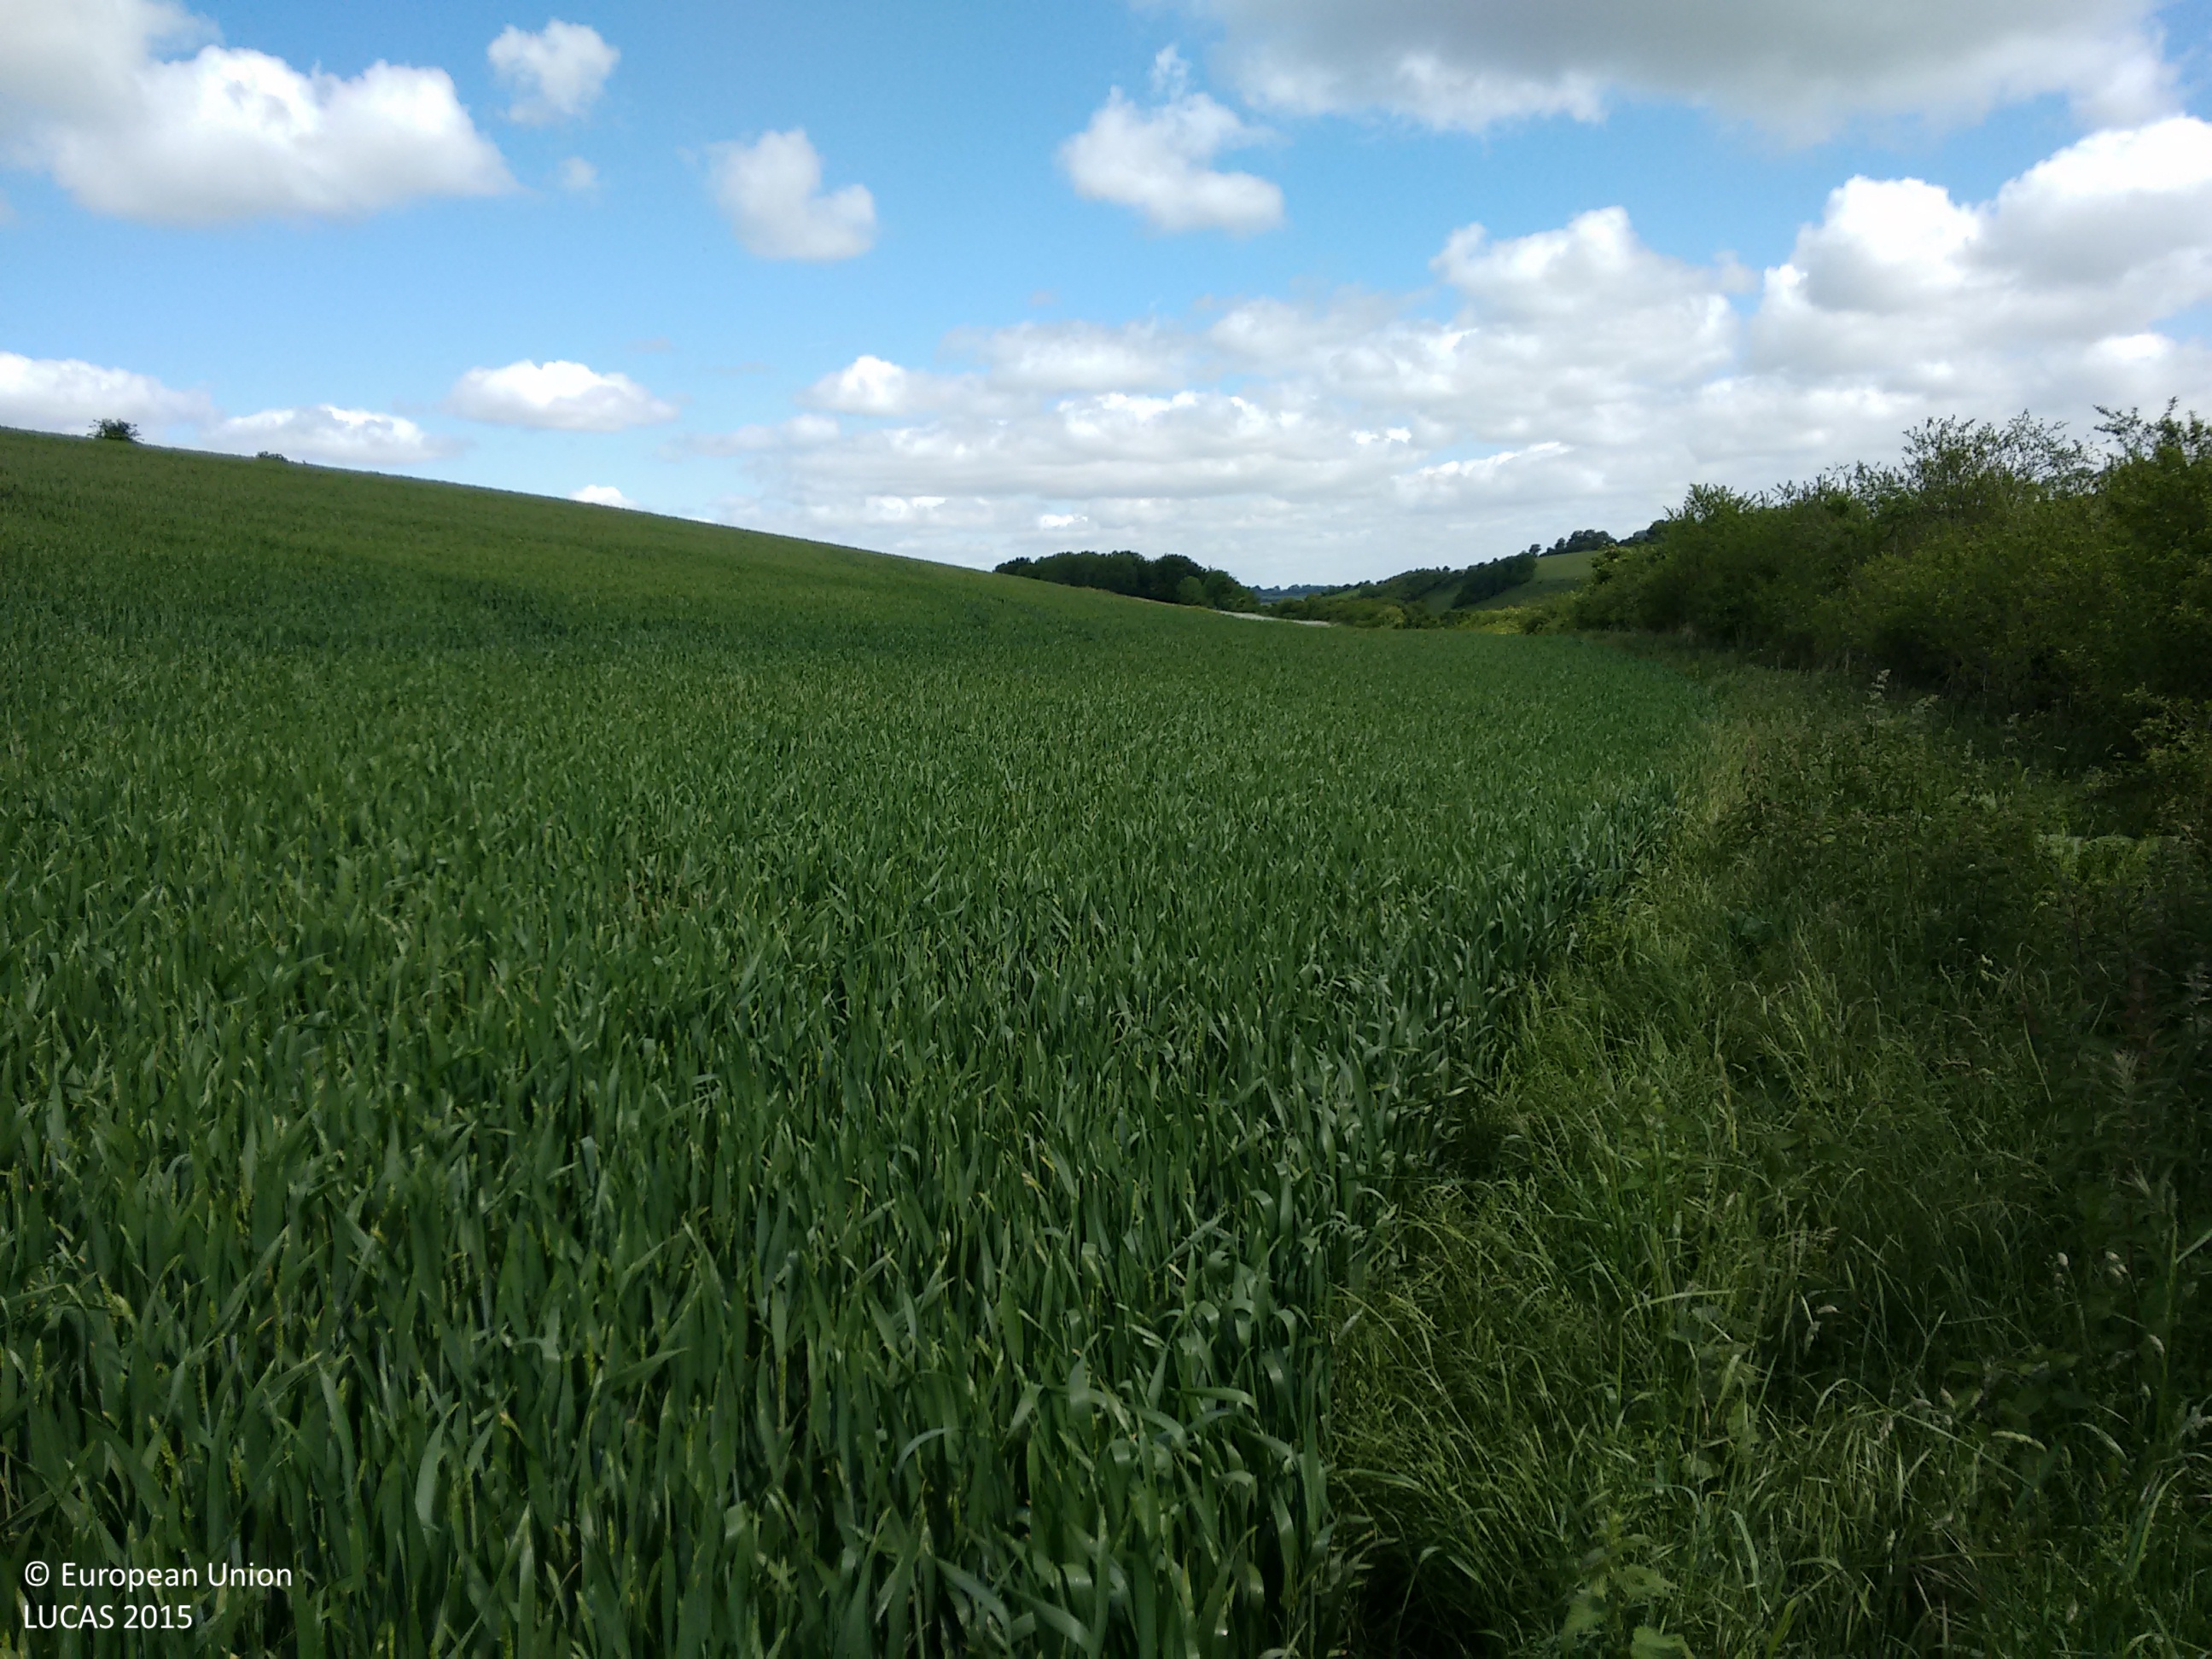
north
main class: Cropland
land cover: Common wheat
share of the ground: > 75 %
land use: Agriculture (excluding fallow land and kitchen gardens)
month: June
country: GB
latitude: 51.0185
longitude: -1.8452
